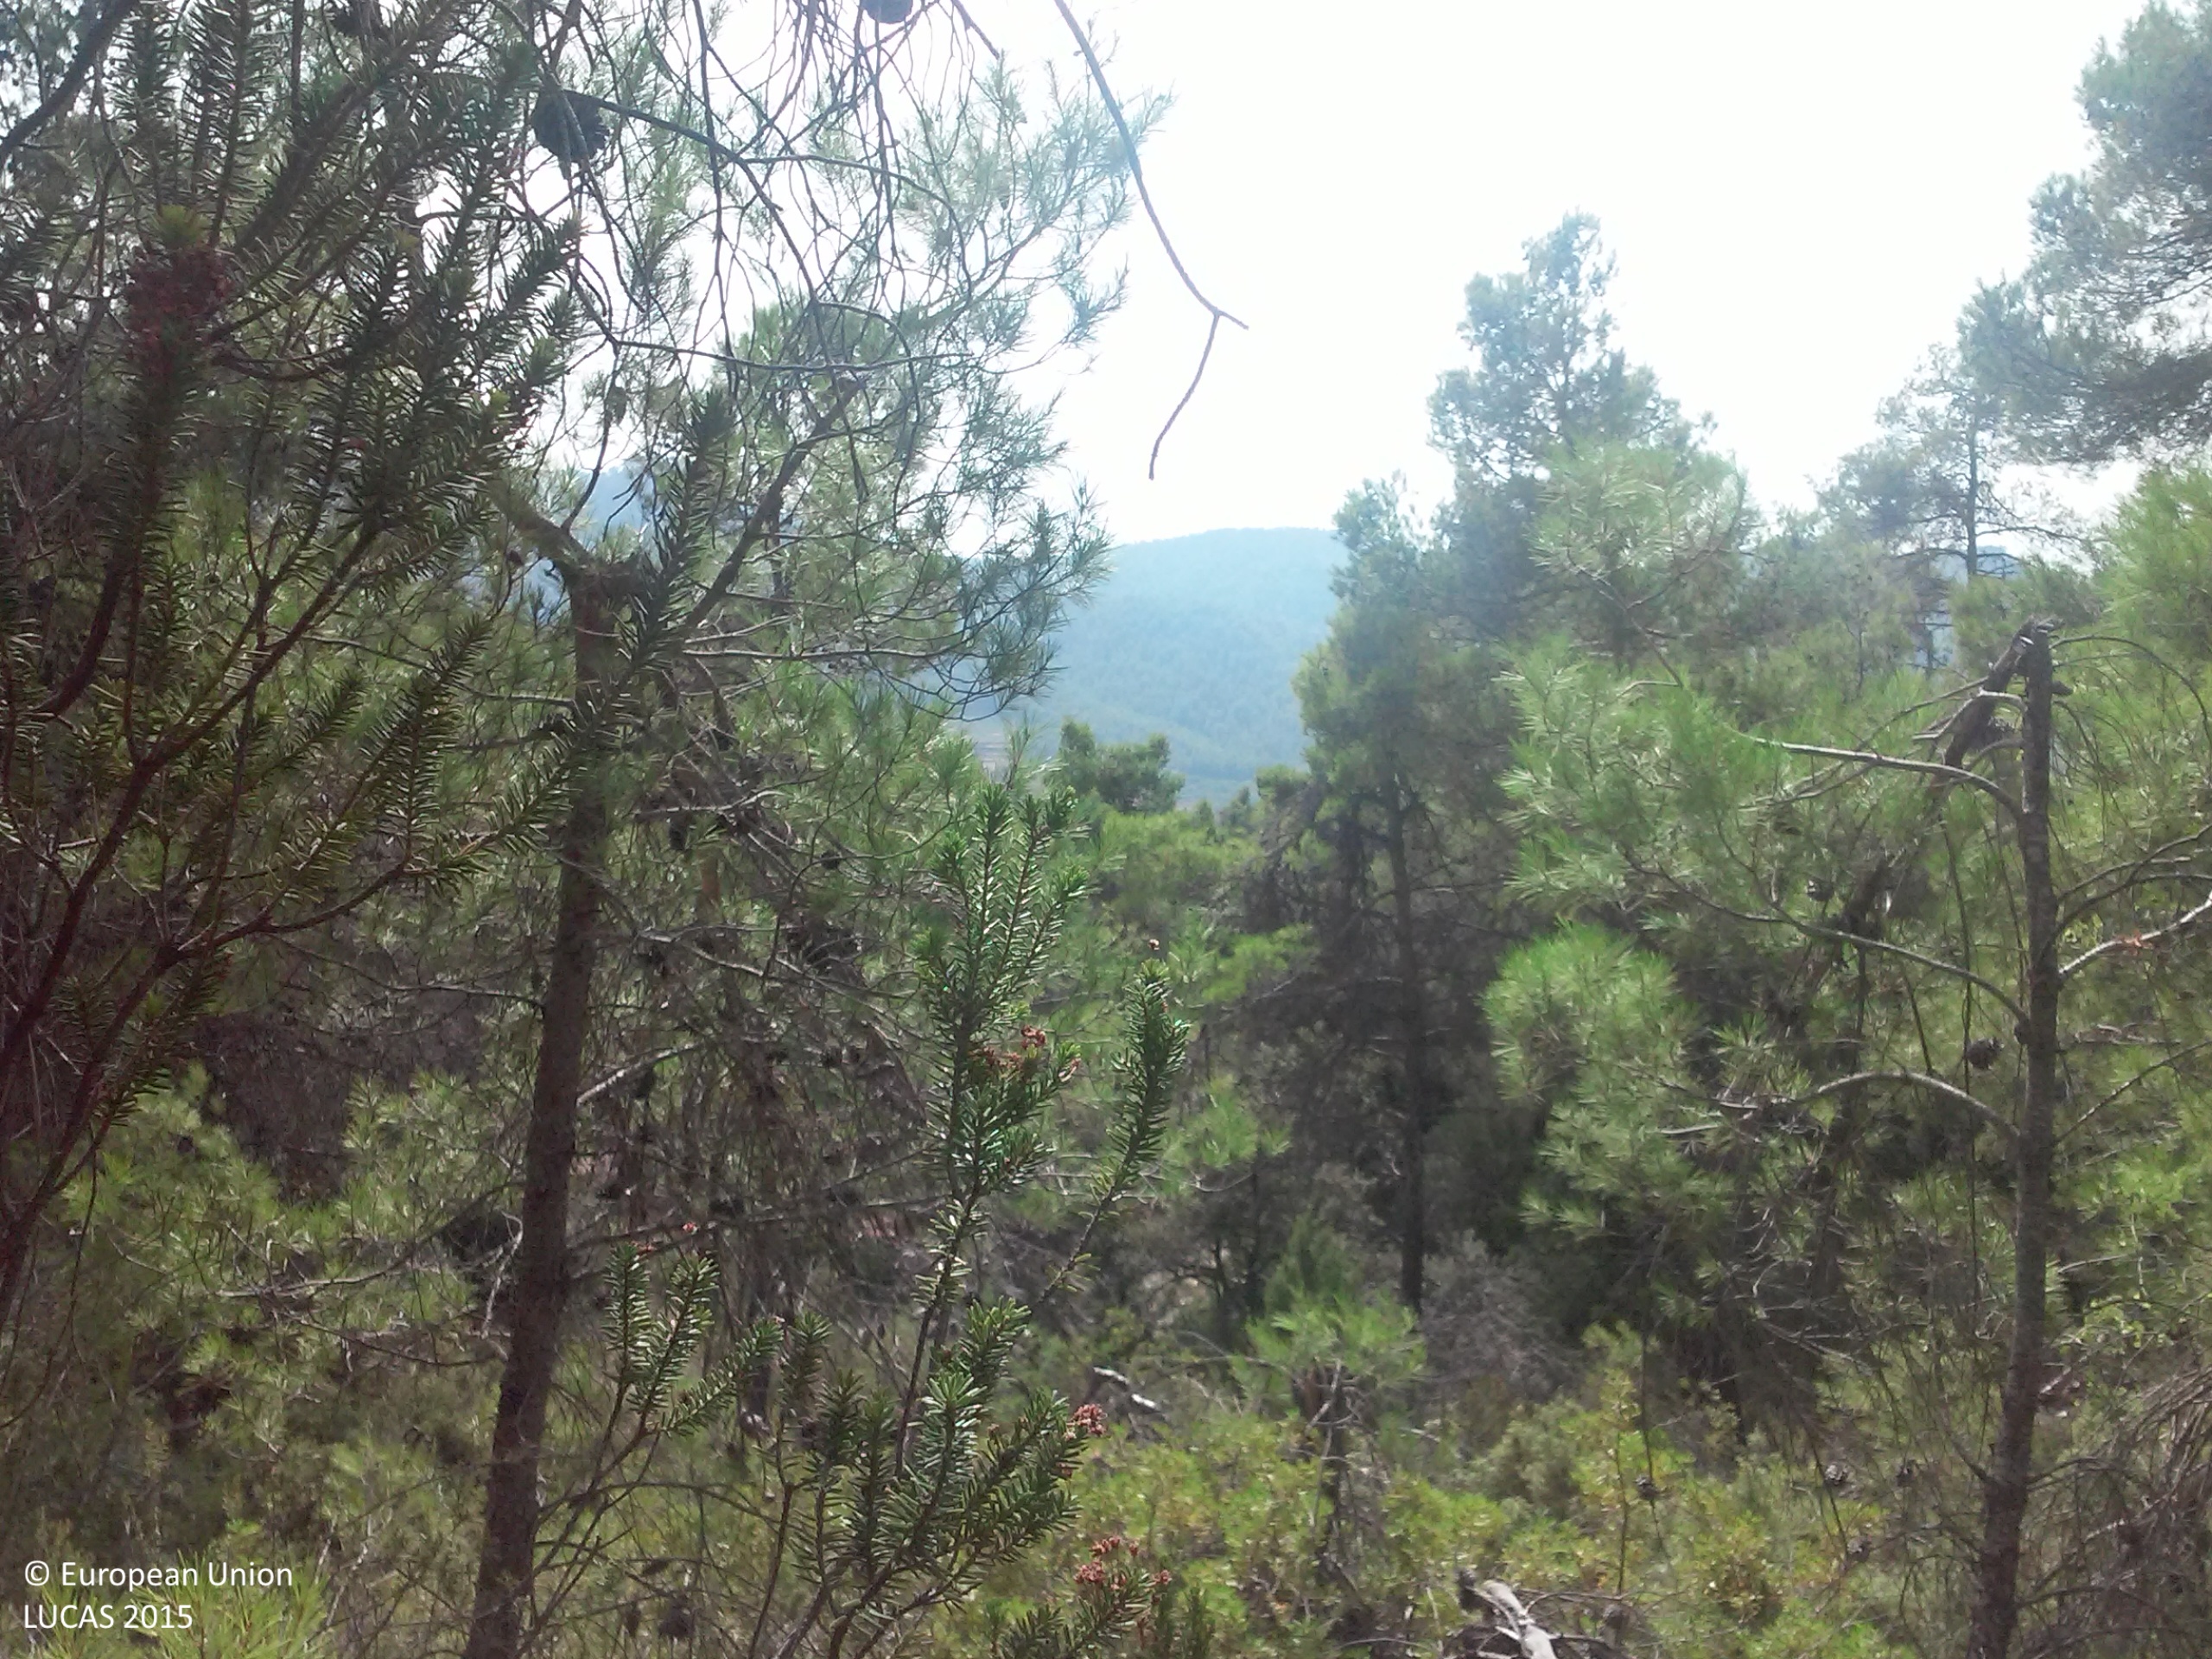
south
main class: Woodland
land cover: Pine dominated coniferous woodland
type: coniferous forest of the mediterranean region
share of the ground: 50 - 75 %
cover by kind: coniferous forest trees 30 %, shrubs 30 %, herbaceous plants 20 %, consolidated bare surface 15 %, broadleaved forest trees 5 %
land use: Semi-natural and natural areas not in use
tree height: > 5 m
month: August
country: ES
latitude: 41.0908
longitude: 0.8140
